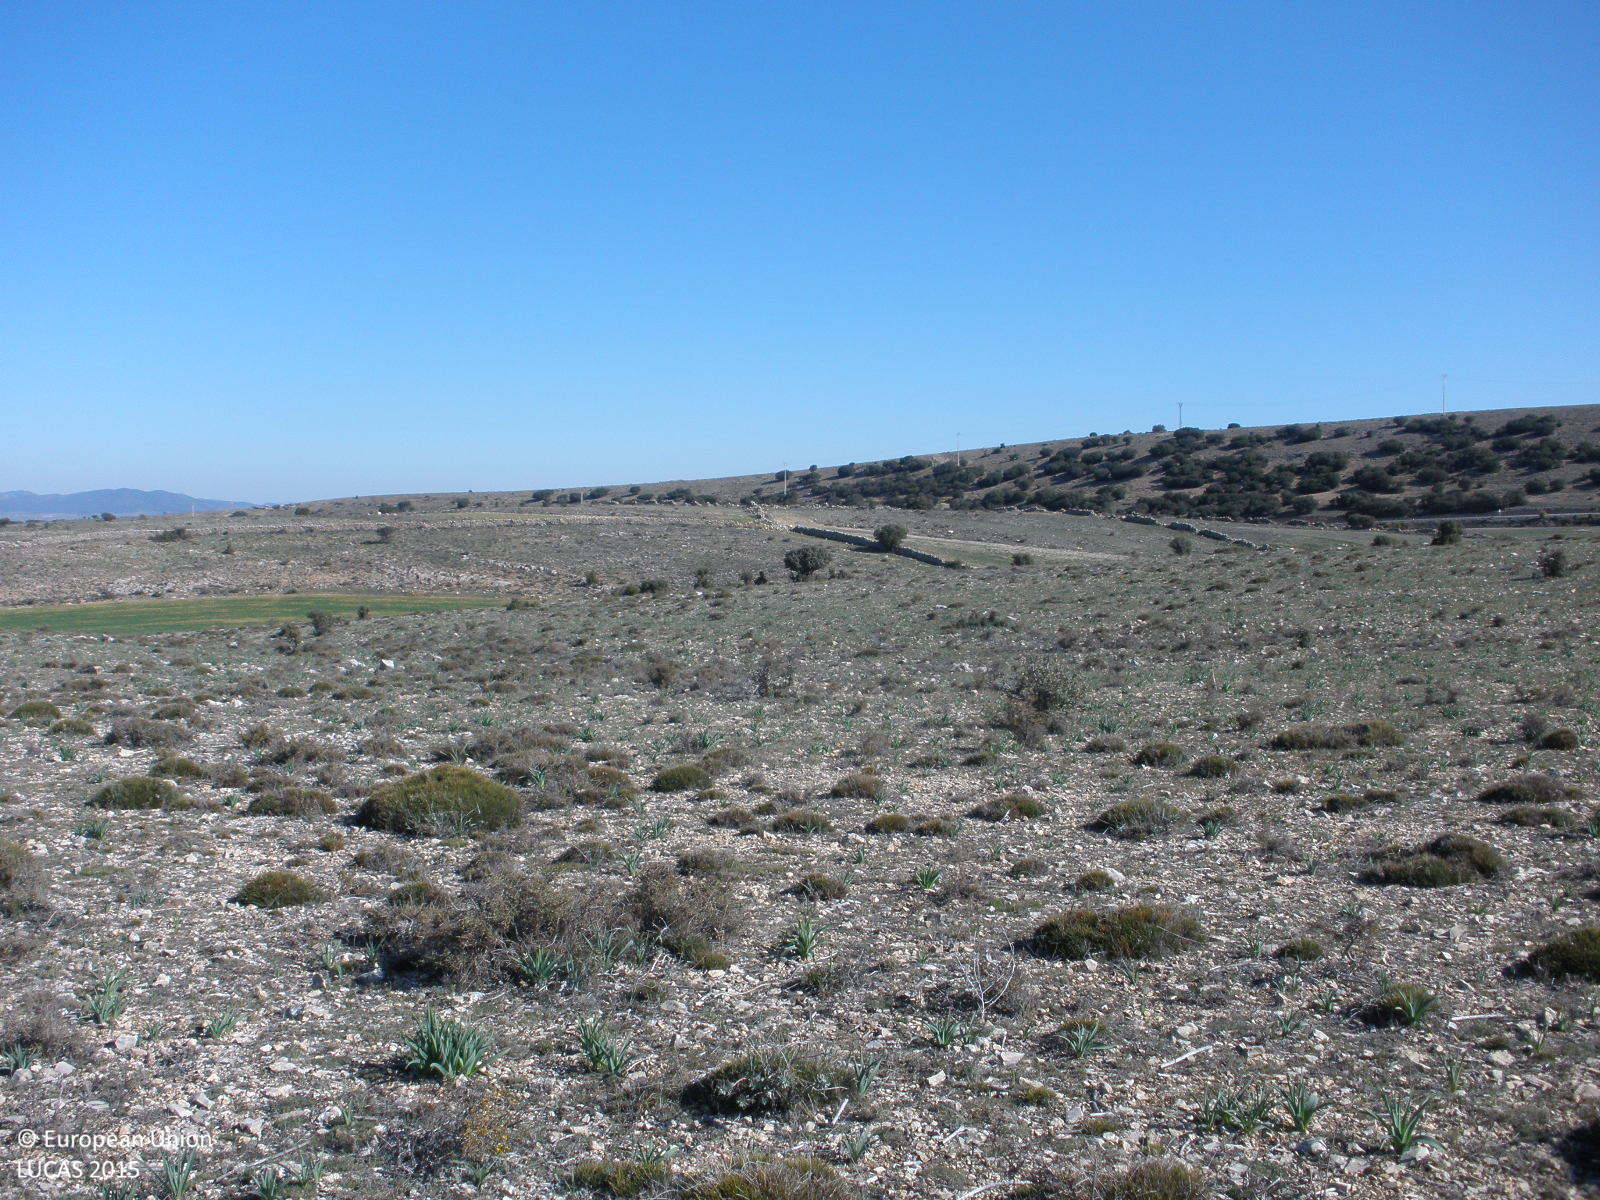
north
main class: Shrubland
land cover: Shrubland without tree cover
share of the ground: > 75 %
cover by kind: consolidated bare surface 50 %, shrubs 25 %, herbaceous plants 25 %
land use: Agriculture (excluding fallow land and kitchen gardens)
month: April
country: ES
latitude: 40.7254
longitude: -1.2990
